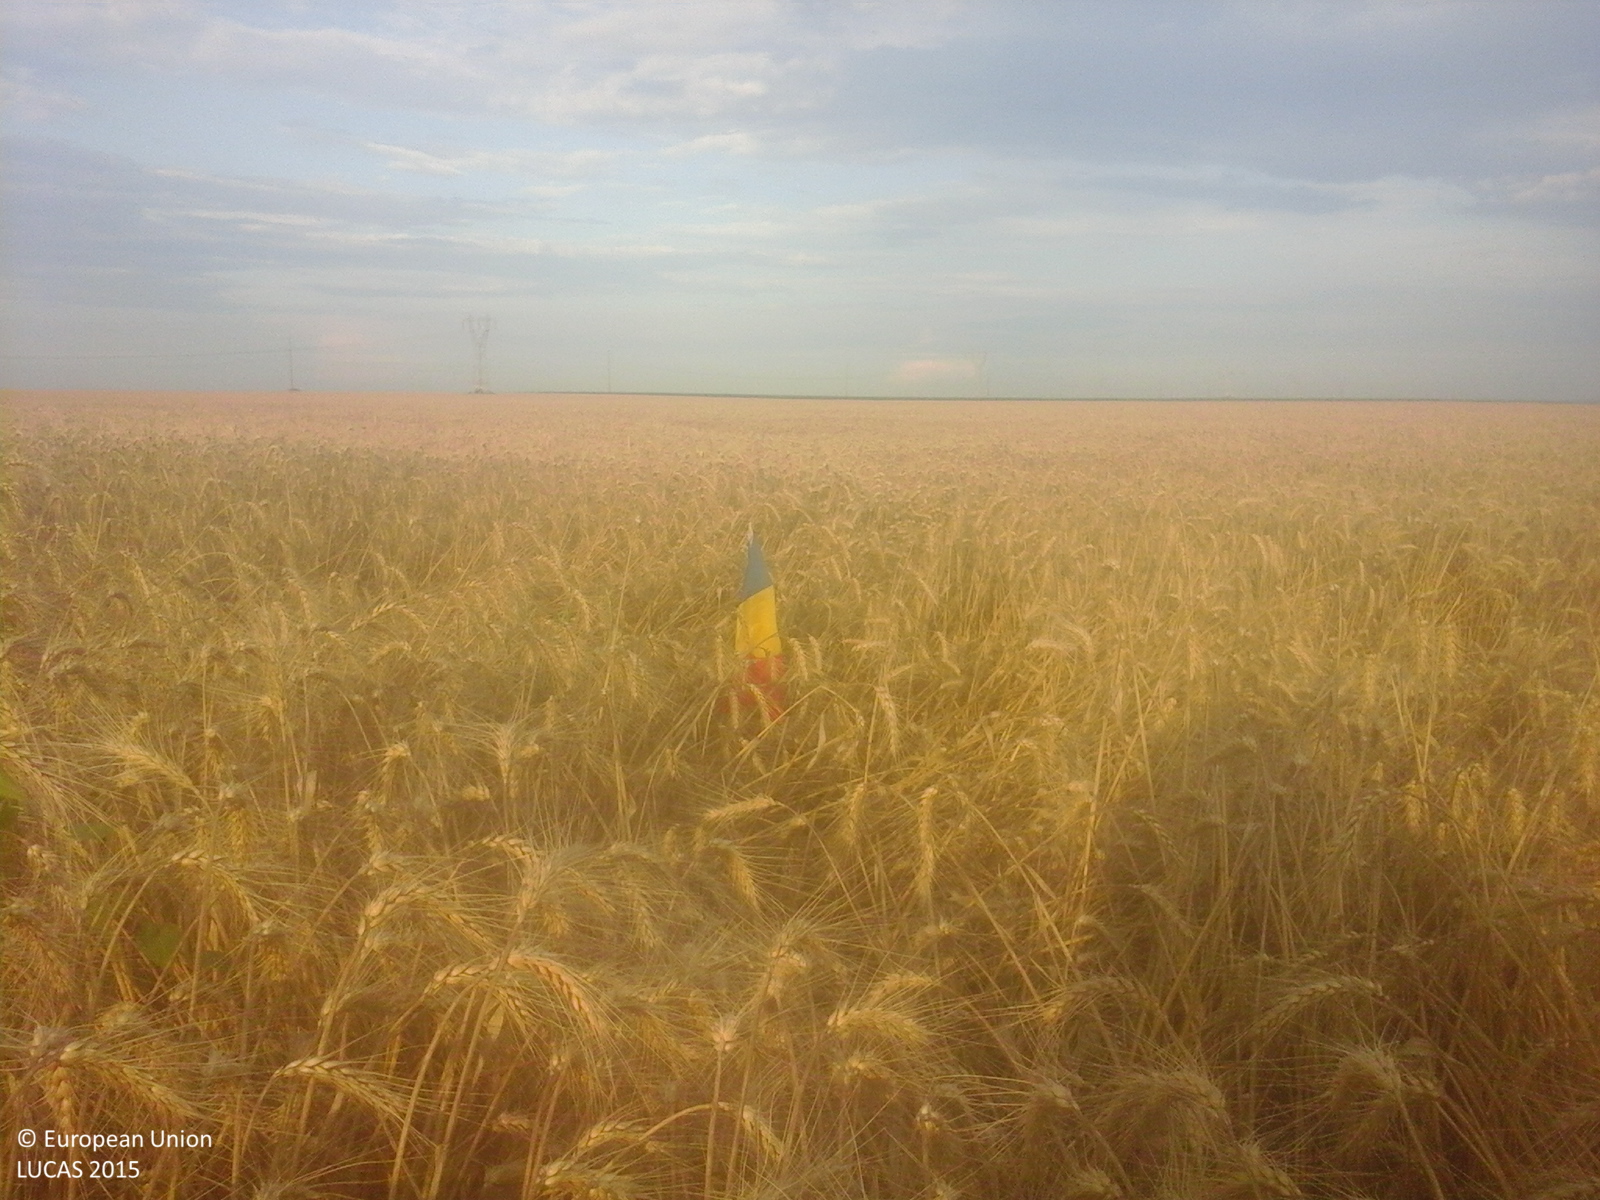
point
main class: Cropland
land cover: Common wheat
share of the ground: > 75 %
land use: Agriculture (excluding fallow land and kitchen gardens)
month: July
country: RO
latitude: 43.8483
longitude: 24.5578
